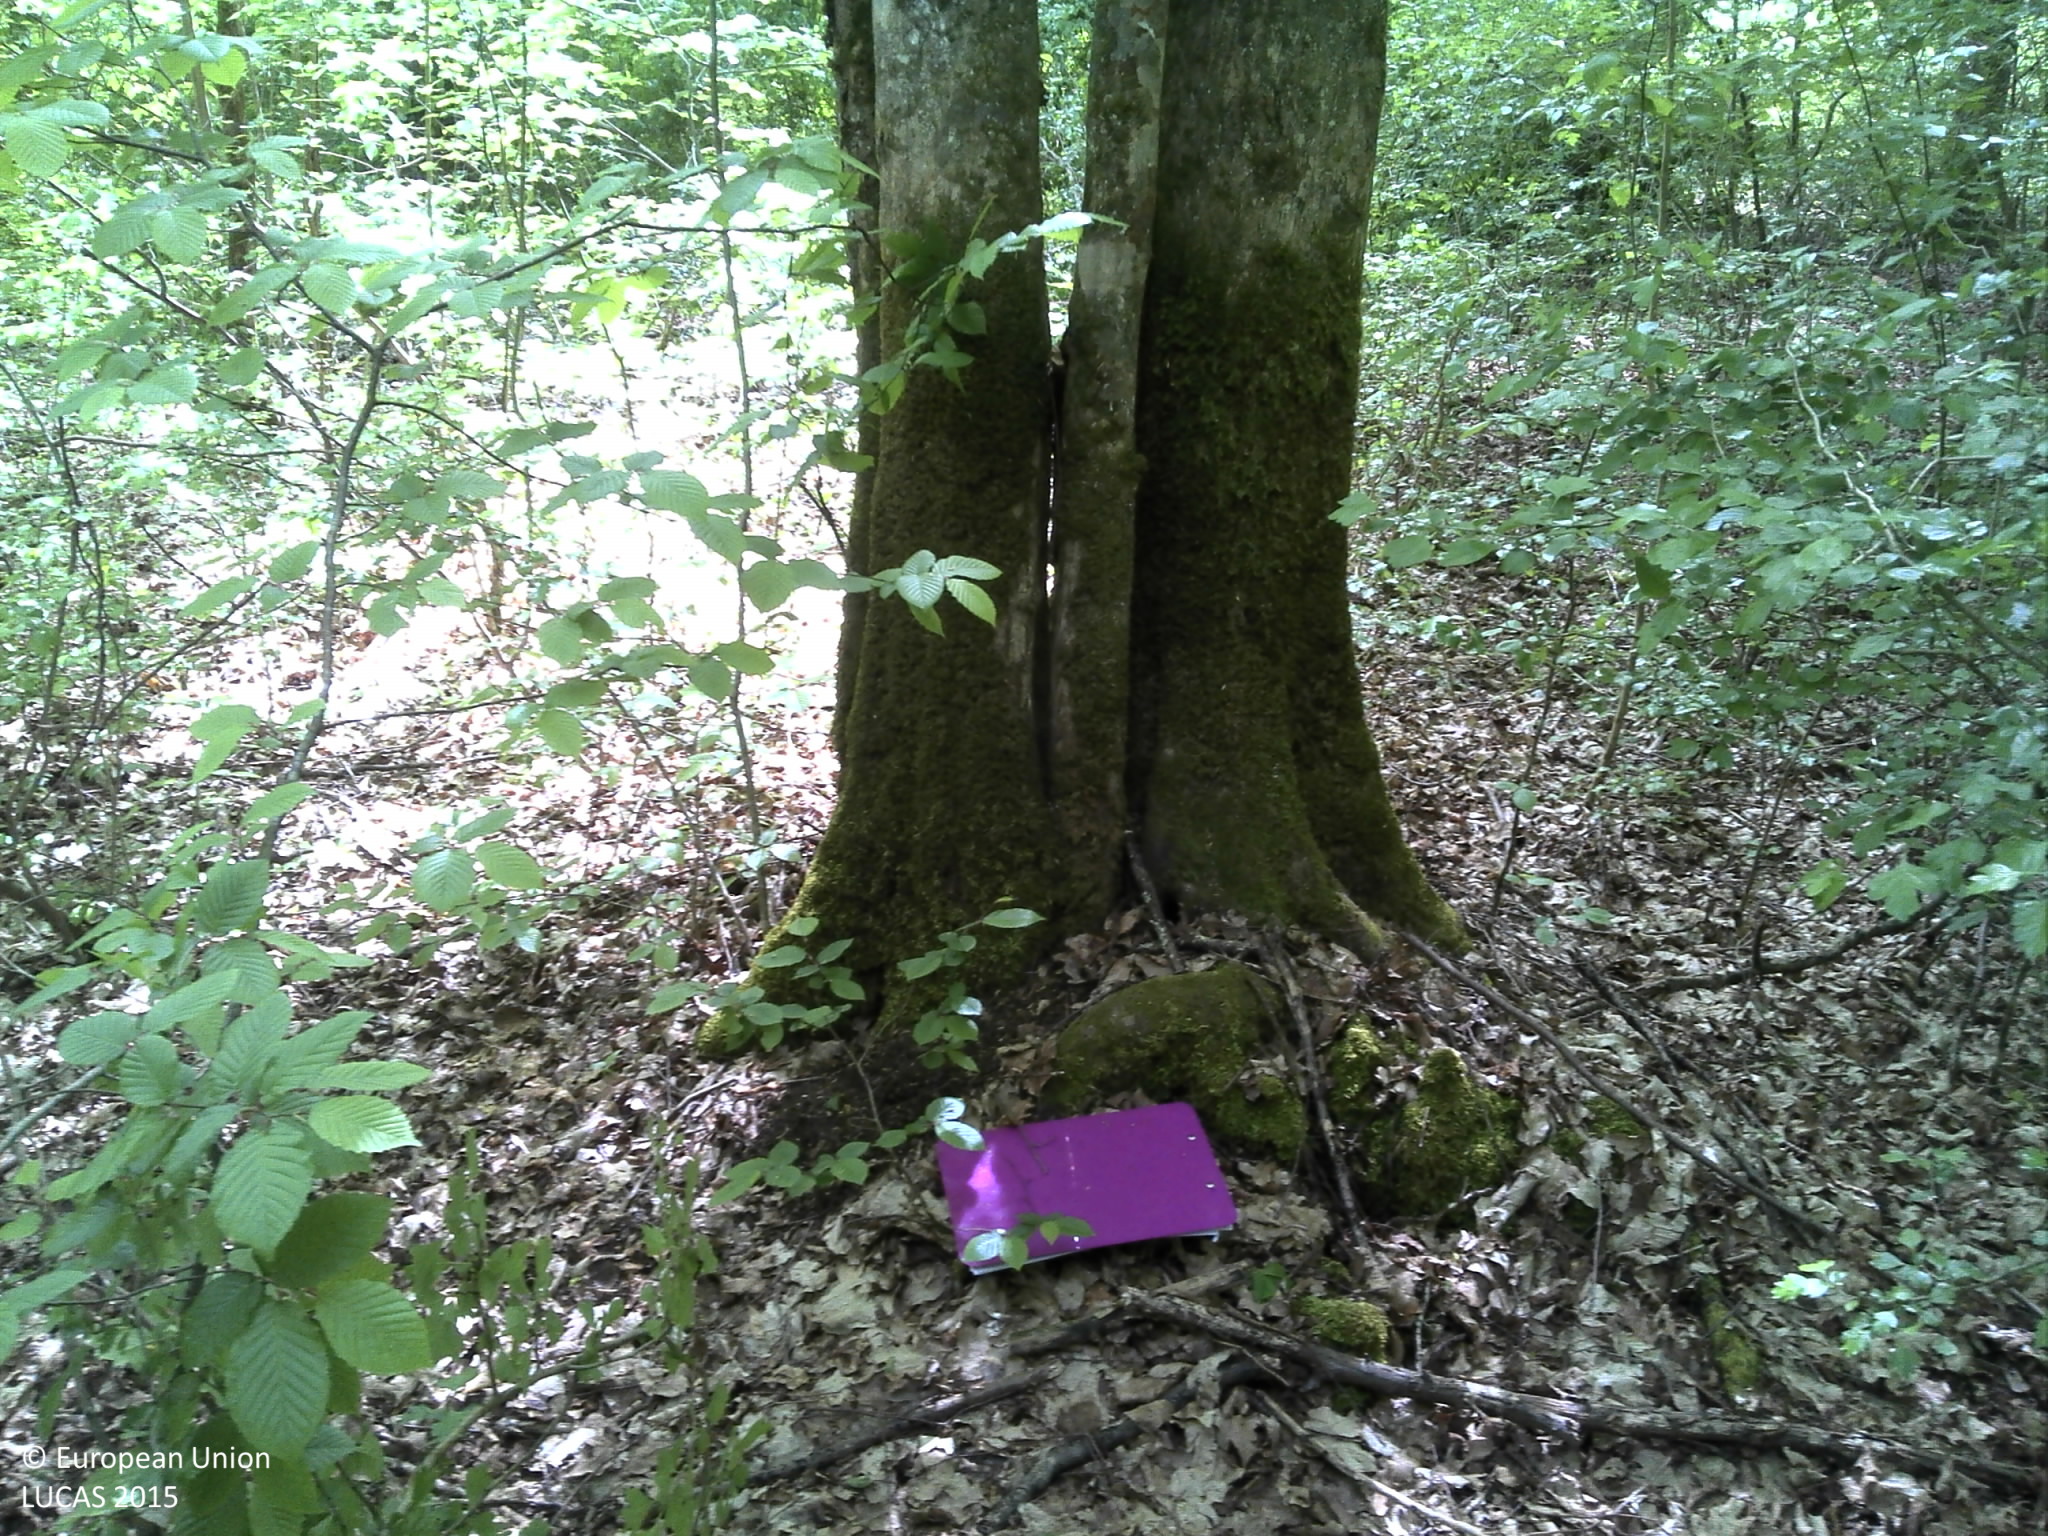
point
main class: Woodland
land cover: Broadleaved woodland
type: mesophytic deciduous forest
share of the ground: > 75 %
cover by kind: broadleaved forest trees 100 %
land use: Forestry
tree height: > 5 m
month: April
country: HR
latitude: 45.0769
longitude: 18.8605
